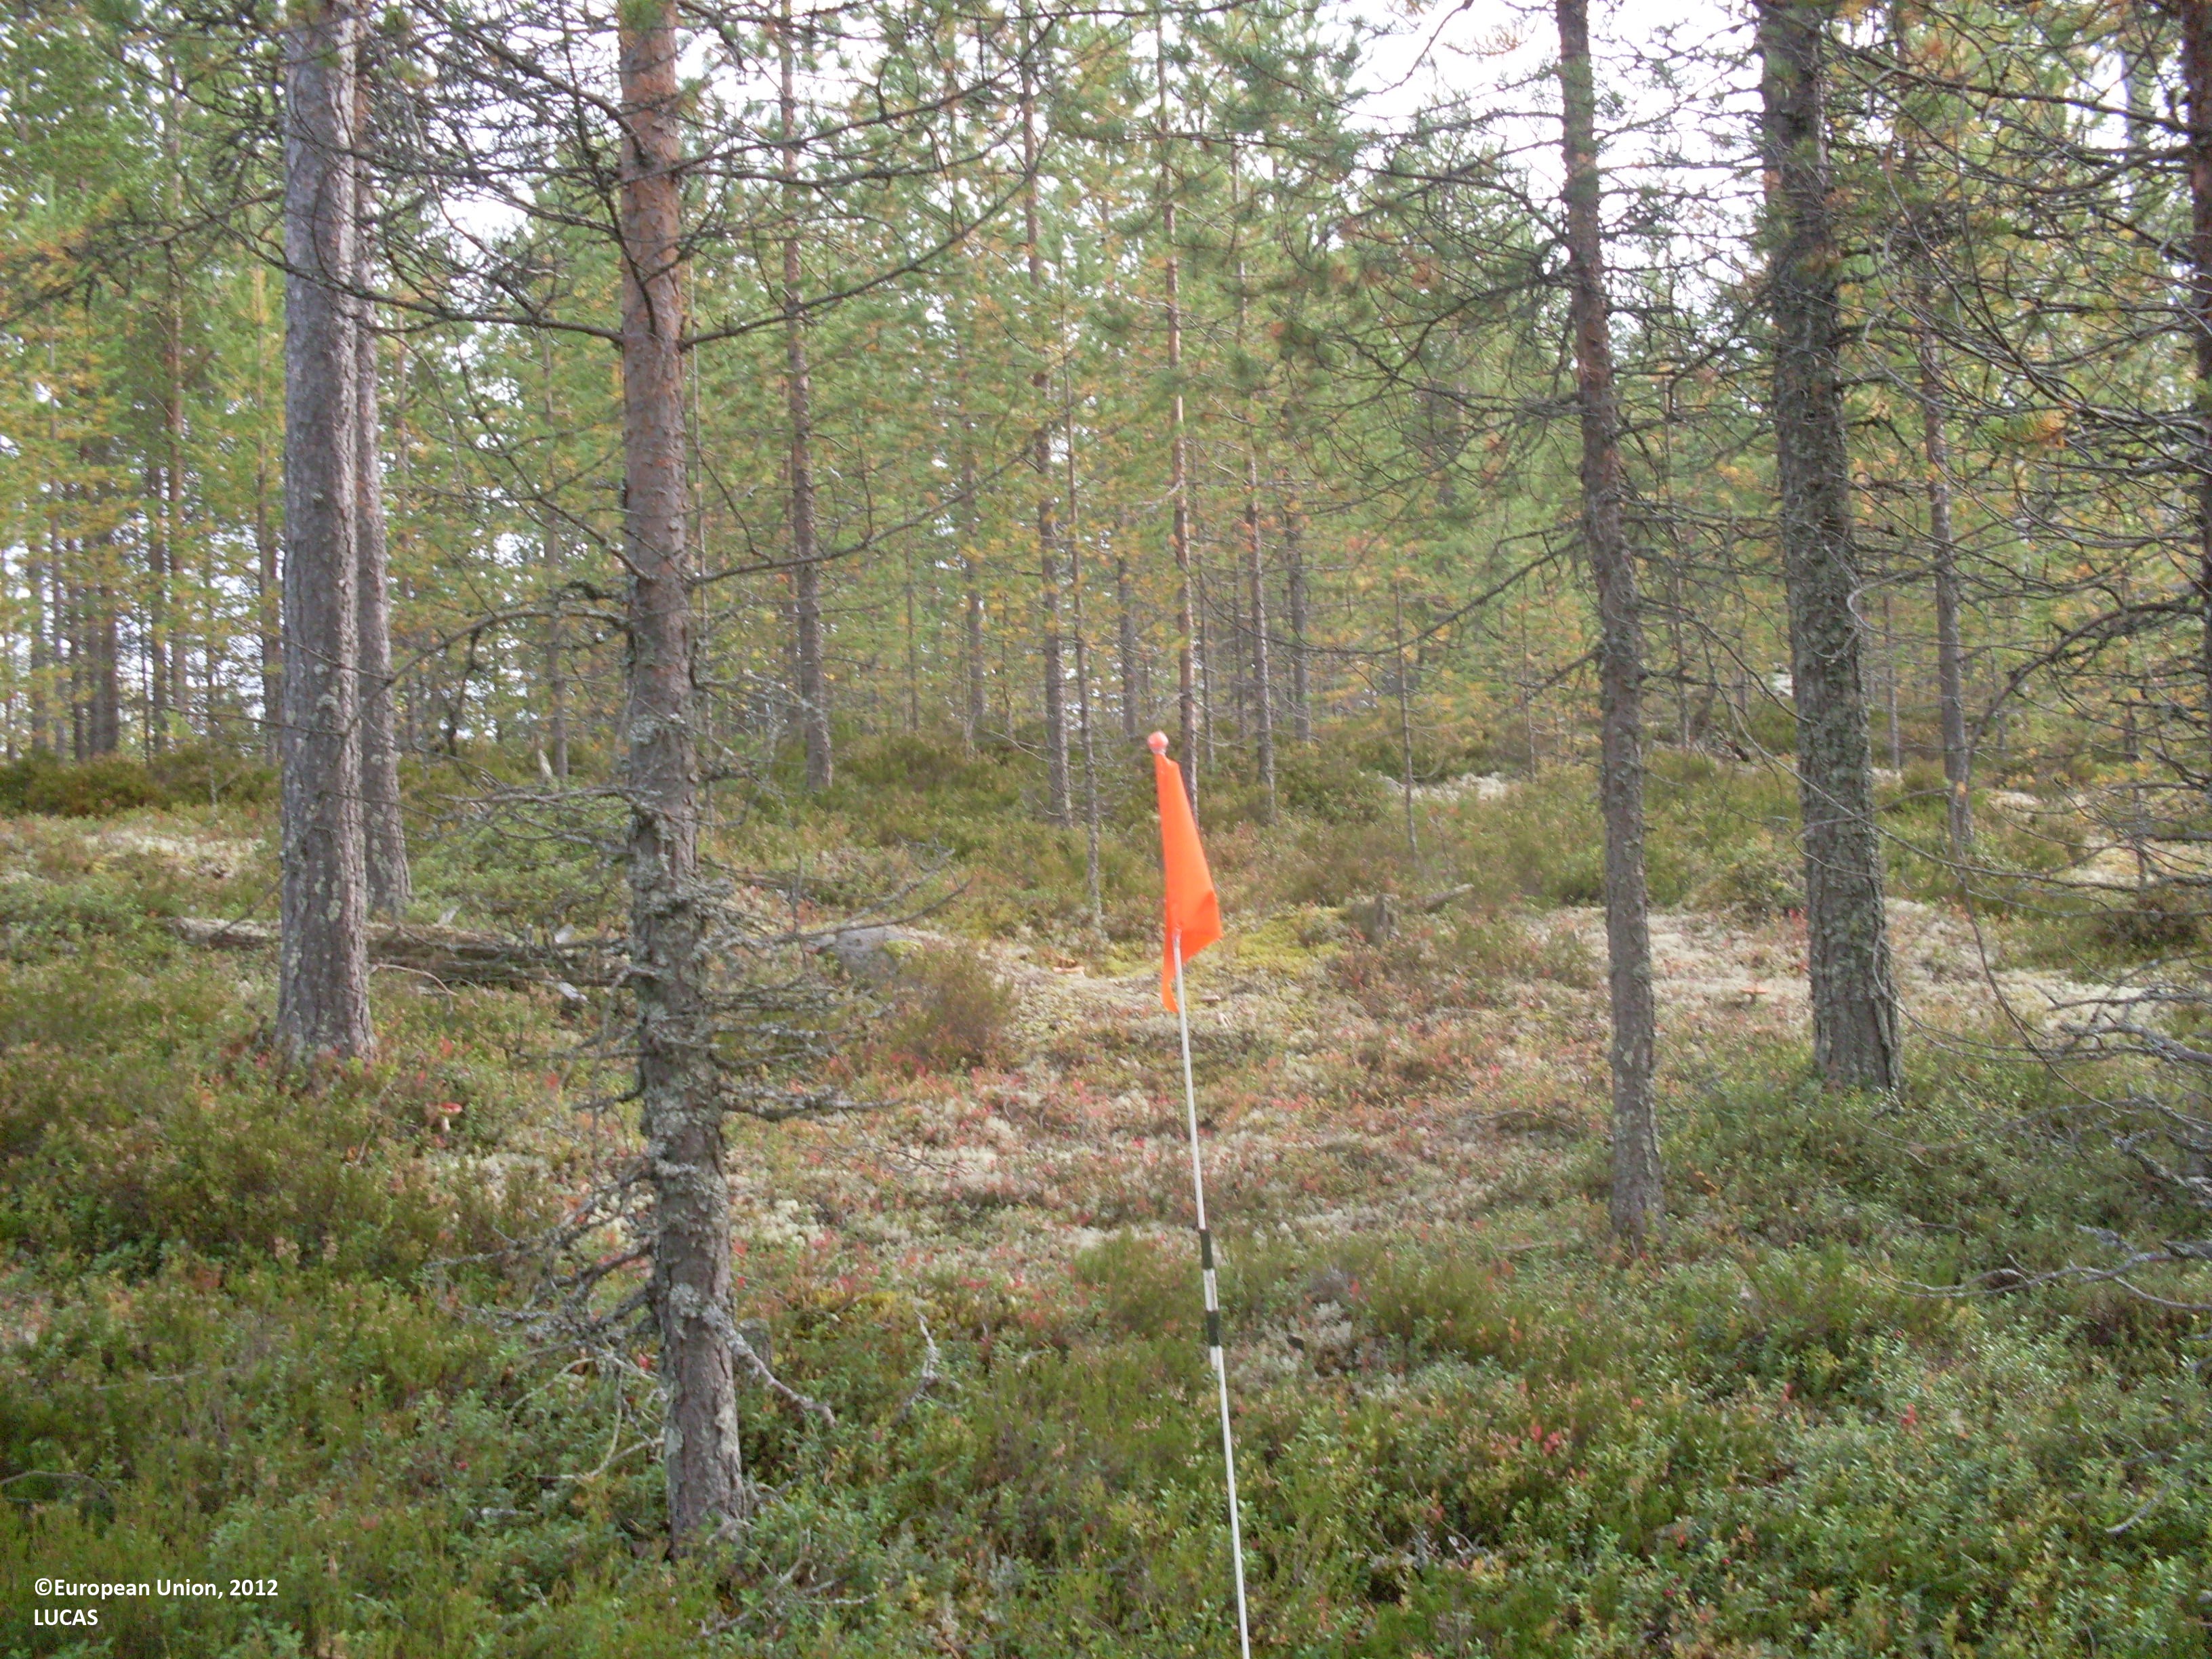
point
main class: Woodland
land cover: Pine dominated coniferous woodland
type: boreal forest
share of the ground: 50 - 75 %
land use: Forestry
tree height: > 5 m
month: September
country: FI
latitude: 64.0789
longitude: 29.5566
